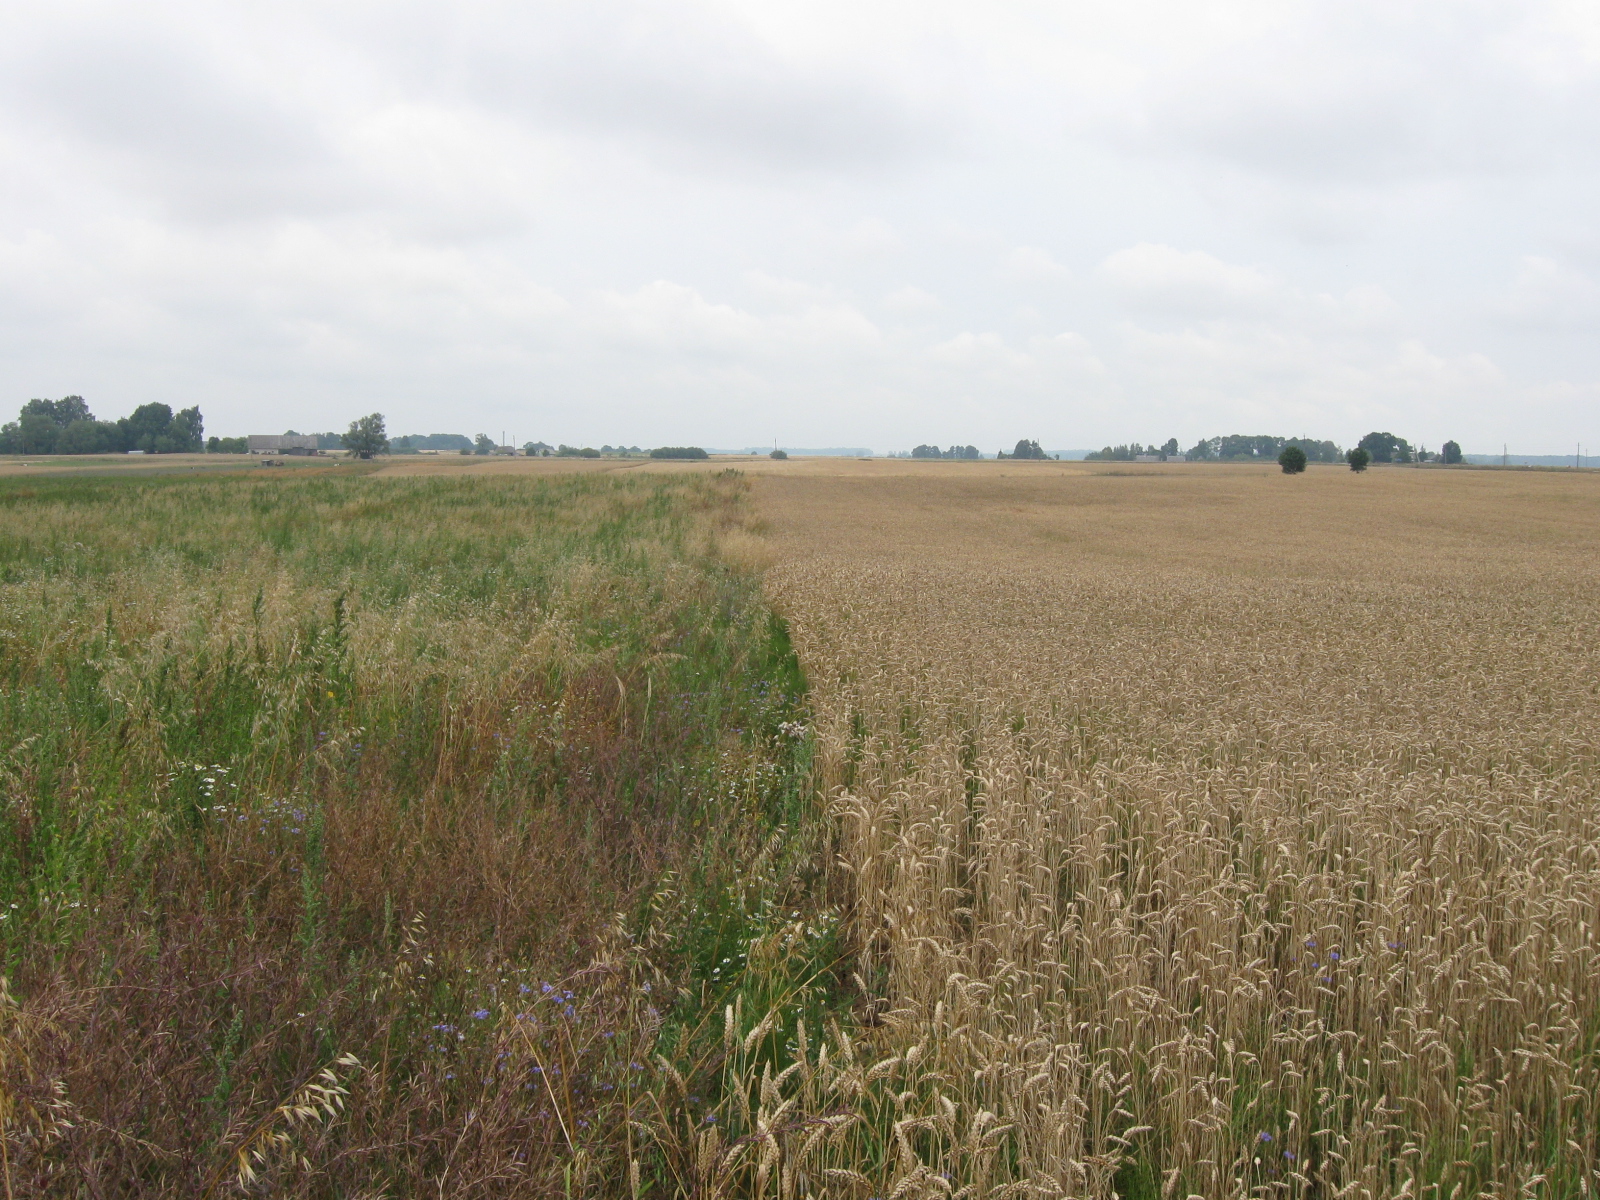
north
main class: Cropland
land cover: Common wheat
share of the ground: > 75 %
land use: Agriculture (excluding fallow land and kitchen gardens)
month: August
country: LT
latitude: 54.6113
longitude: 23.5060
